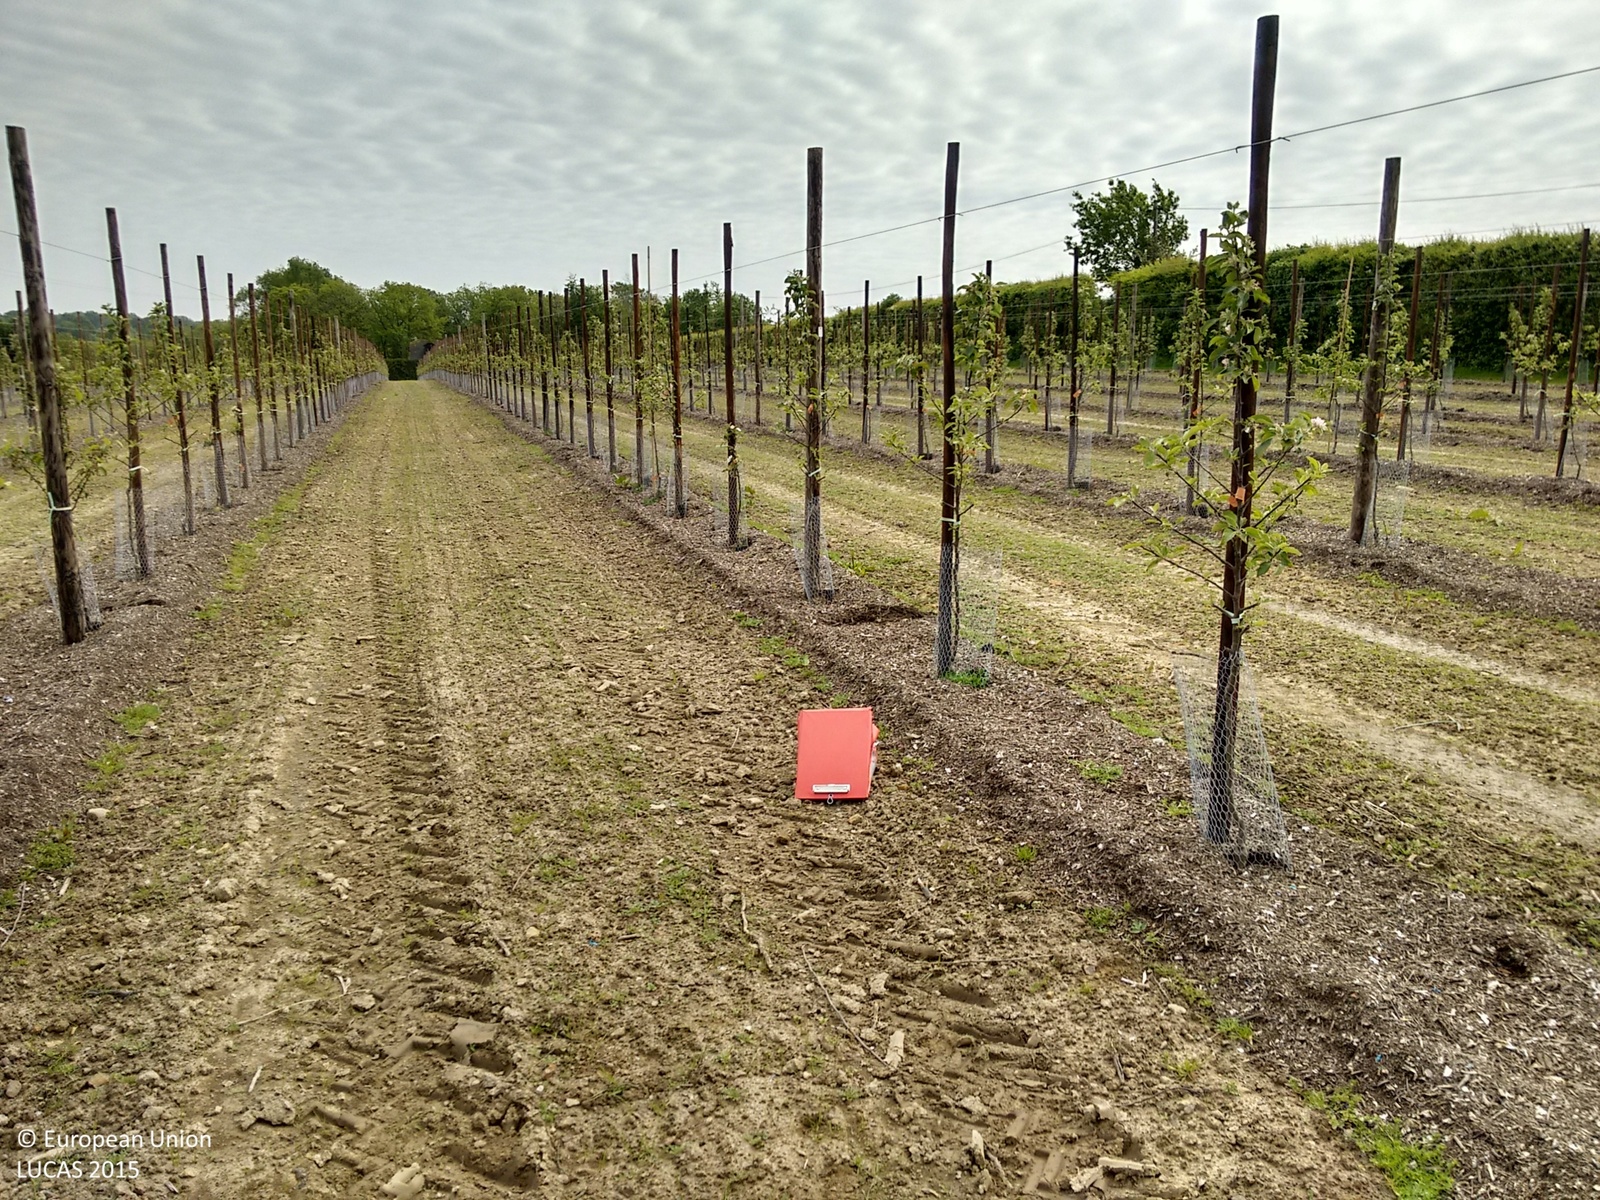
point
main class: Cropland
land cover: Apple fruit
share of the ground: < 10 %
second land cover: Spontaneously vegetated surfaces
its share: < 10 %
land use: Agriculture (excluding fallow land and kitchen gardens)
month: May
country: GB
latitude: 51.1504
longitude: 0.3494
